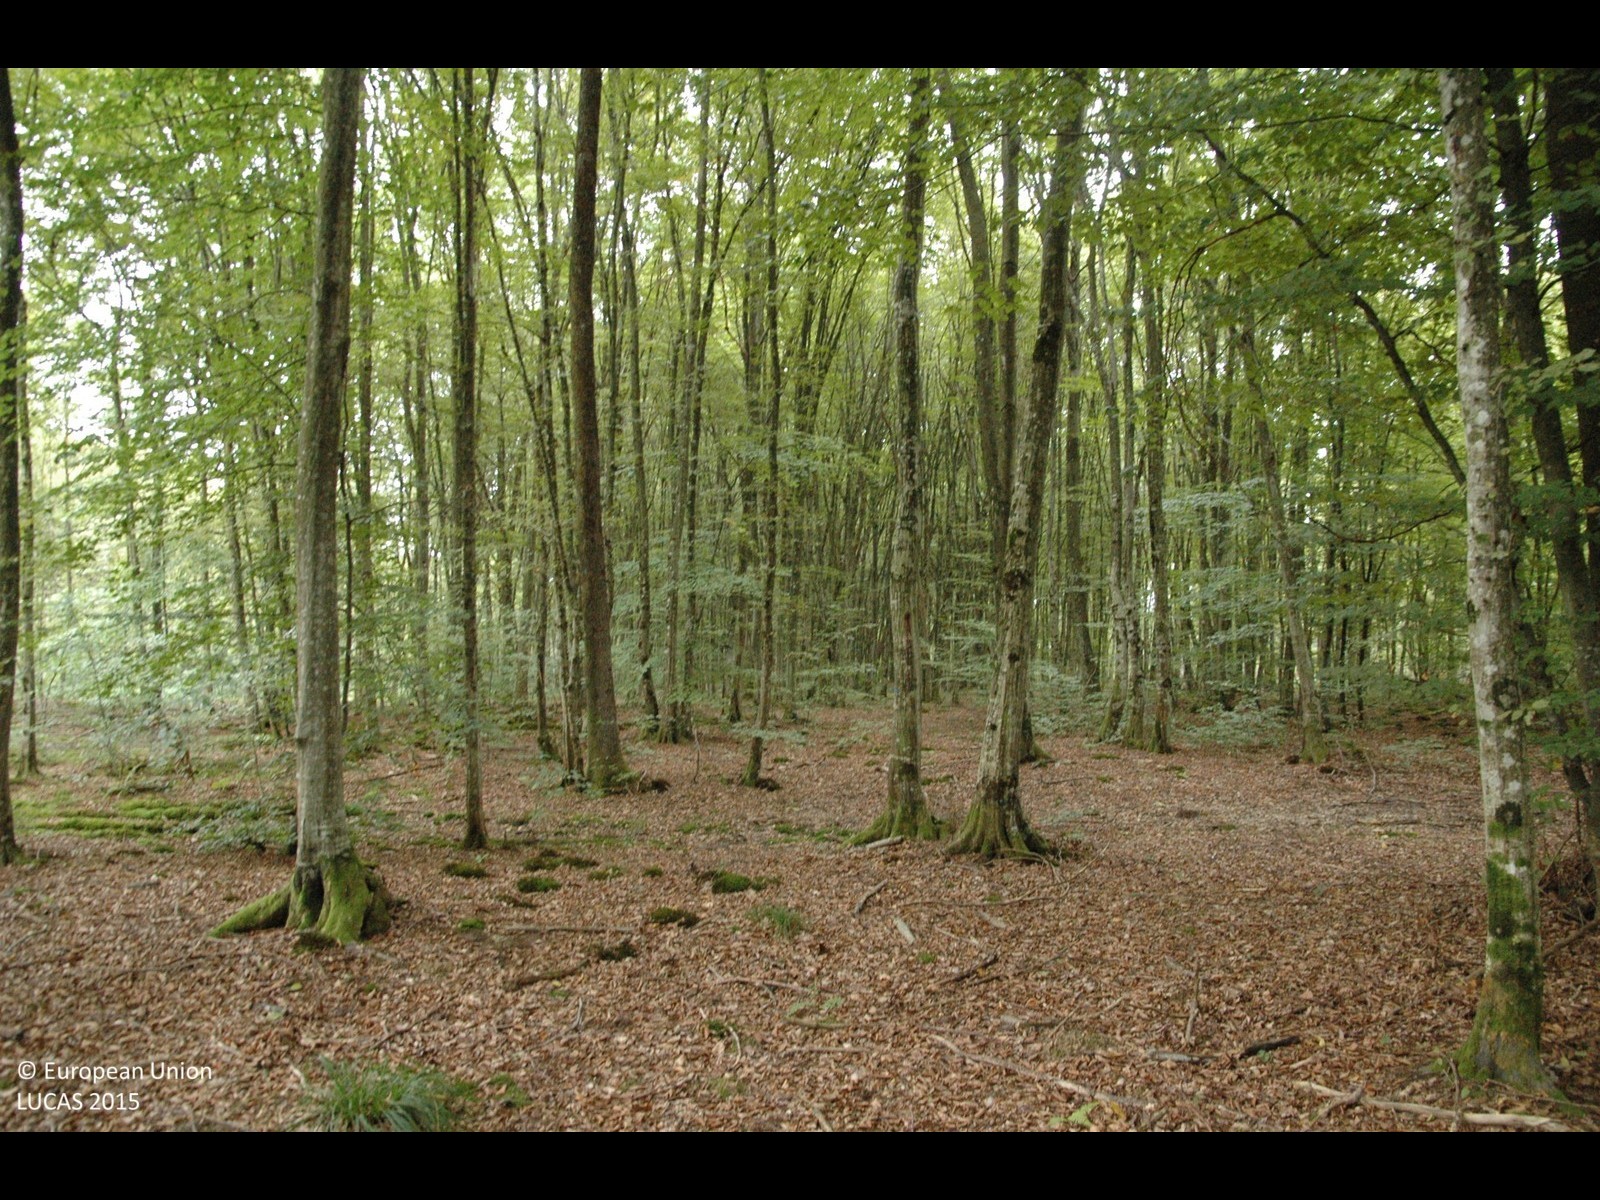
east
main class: Woodland
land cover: Broadleaved woodland
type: beech forest
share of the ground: > 75 %
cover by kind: broadleaved forest trees 100 %
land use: Forestry
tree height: > 5 m
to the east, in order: Broadleaved woodland
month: October
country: HR
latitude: 45.5609
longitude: 16.1342
